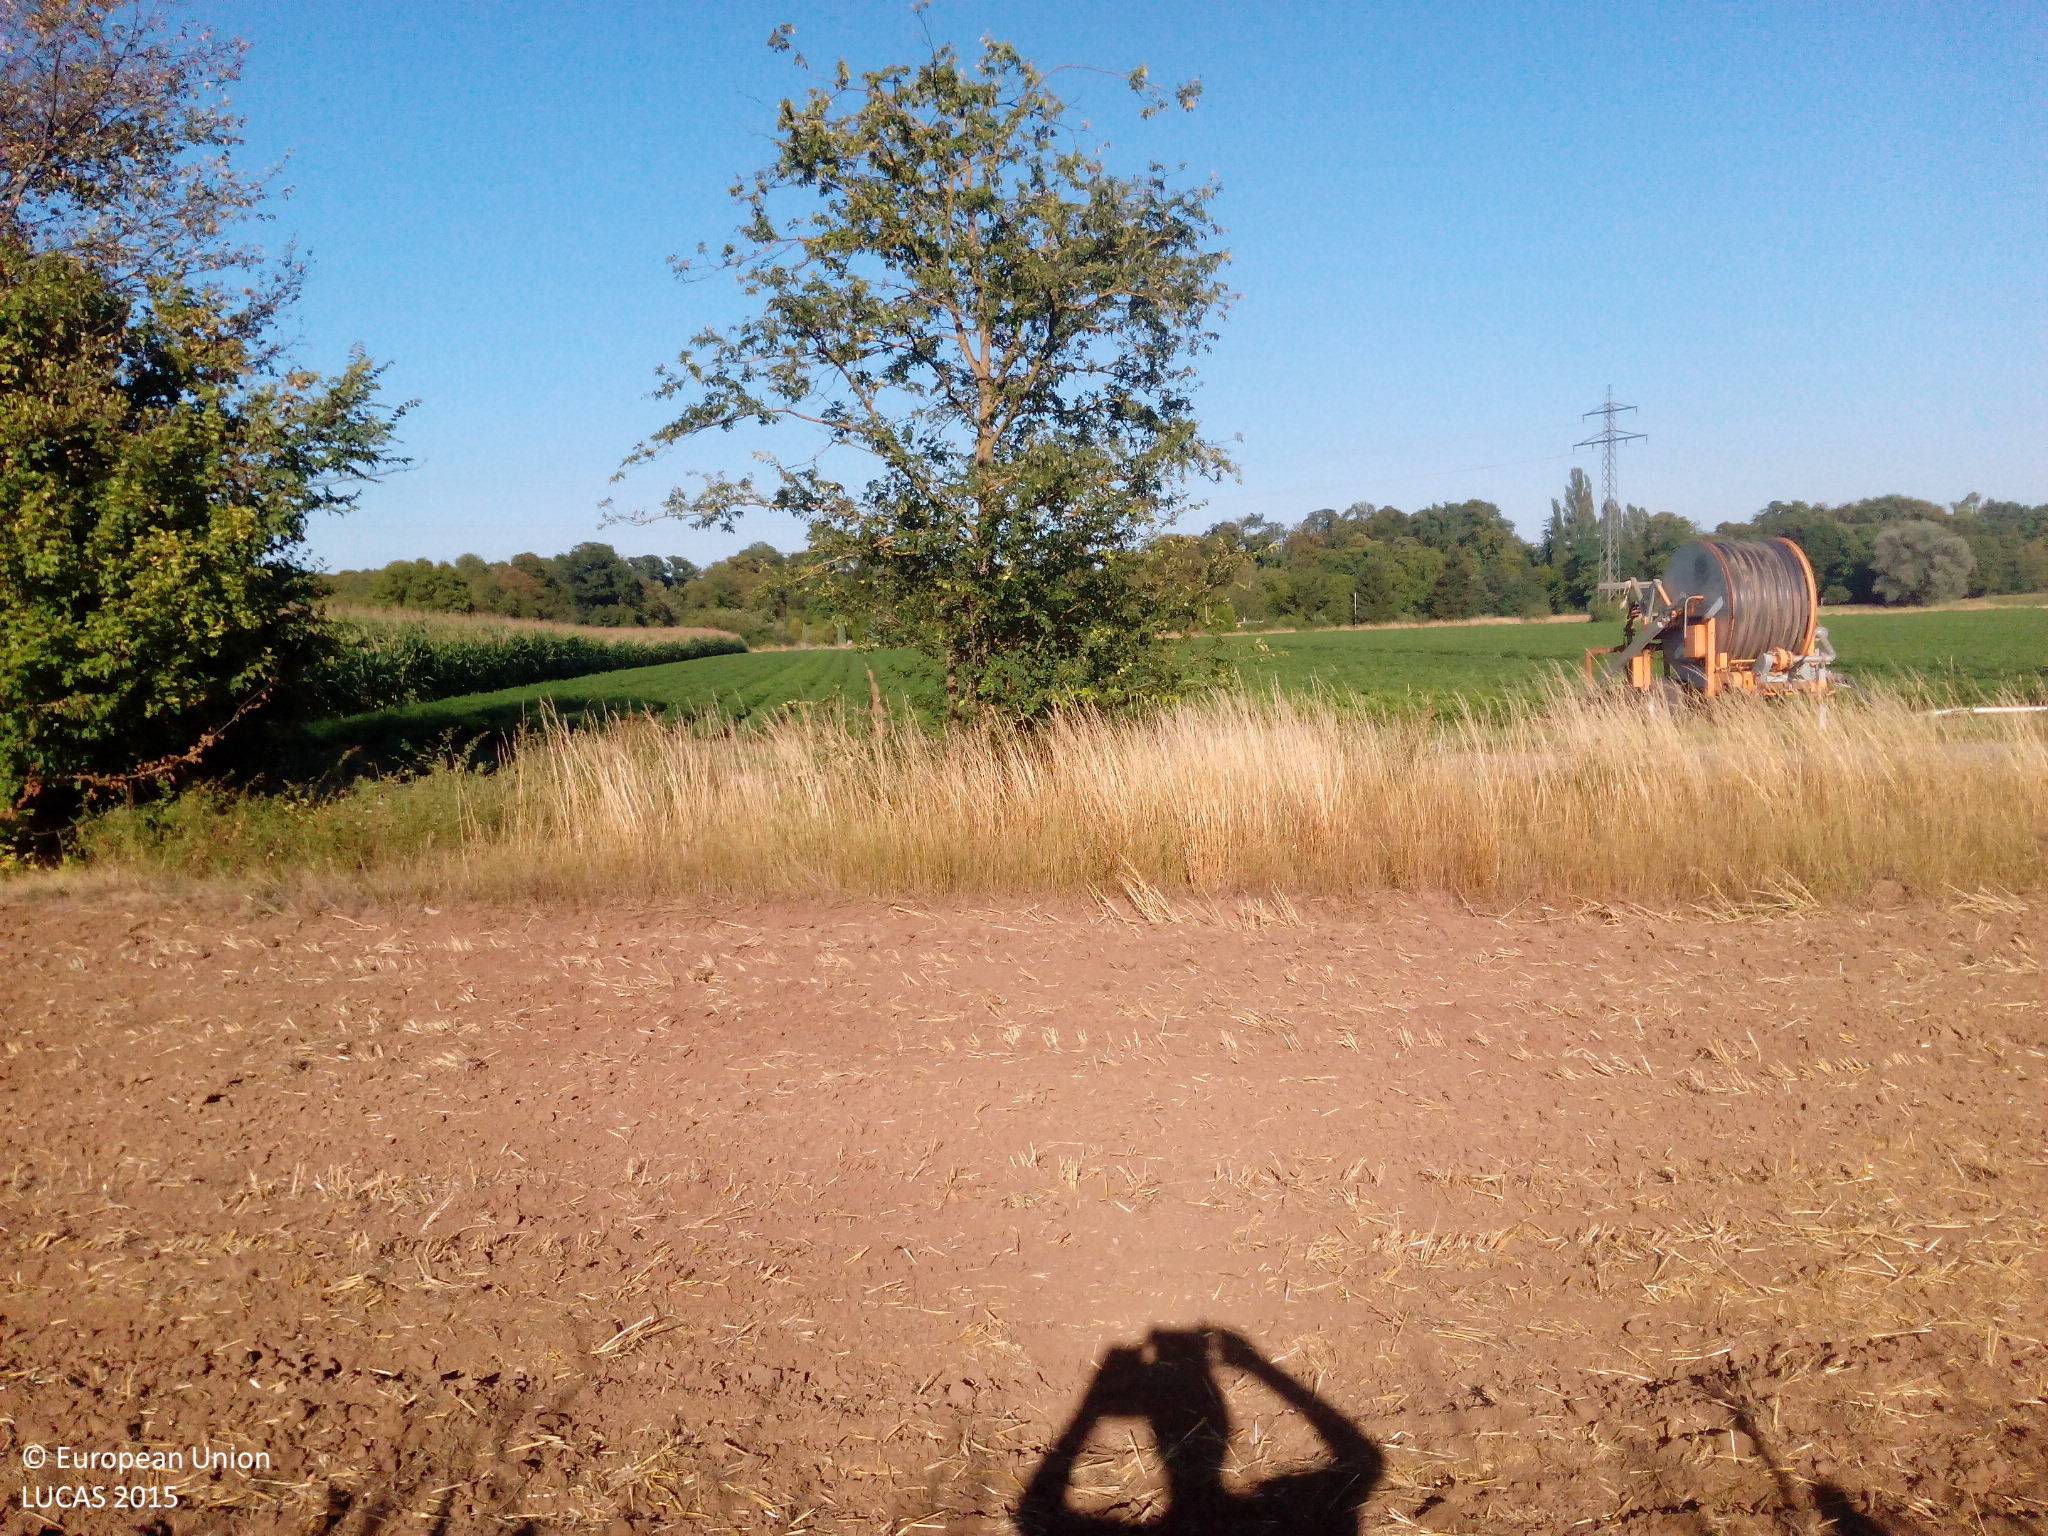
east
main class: Cropland
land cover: Maize
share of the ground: > 75 %
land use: Agriculture (excluding fallow land and kitchen gardens)
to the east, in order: Maize; Other bare soil; Shruby margins; Lines of trees; Paved roads, cycling and walking lanes; Grass margins; Other fresh vegetables; Electric lines; Other fresh vegetables; Grassland without tree/shrub cover; Tracks; Other bare soil; Shruby margins; Artificial constructions in urban areas
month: August
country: DE
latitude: 49.3836
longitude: 8.5541
